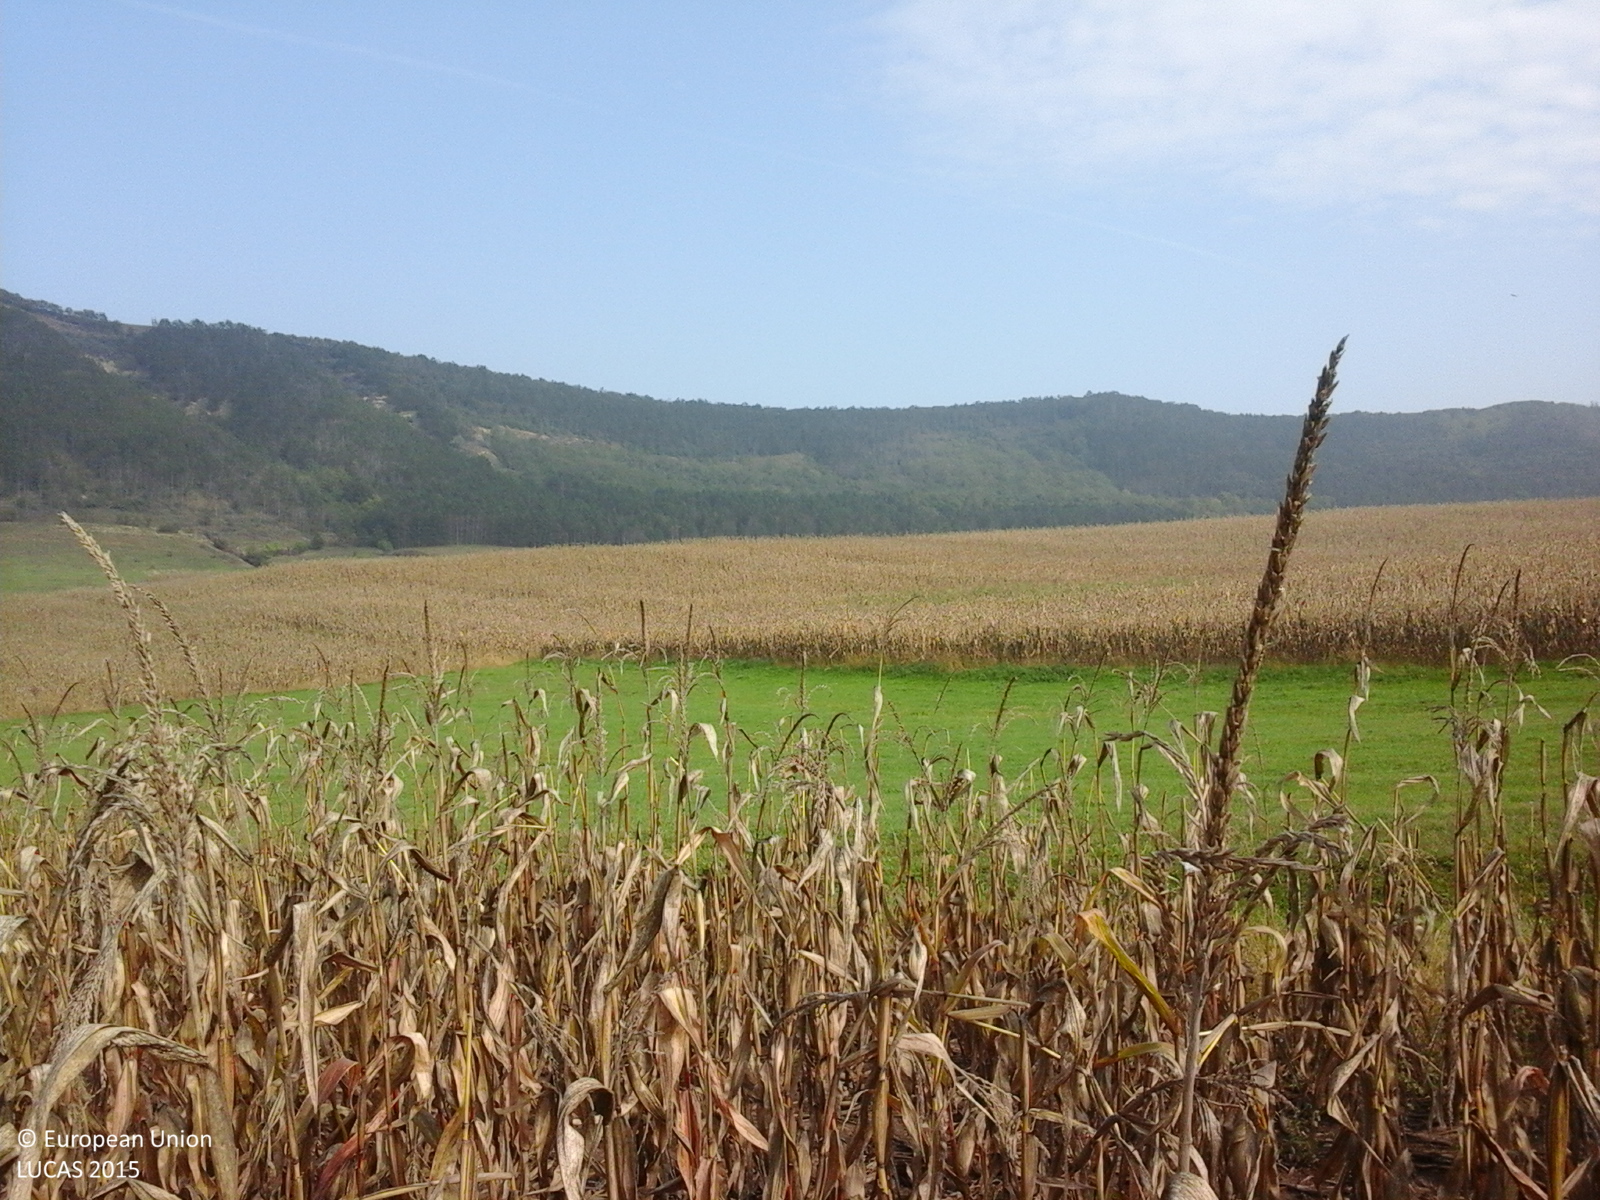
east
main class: Cropland
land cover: Maize
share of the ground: > 75 %
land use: Agriculture (excluding fallow land and kitchen gardens)
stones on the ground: < 10 %
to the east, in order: Maize; Grassland without tree/shrub cover; Lines of trees; Ditches and canals; Grassland without tree/shrub cover; Maize
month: October
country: RO
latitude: 46.5731
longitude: 24.1589
